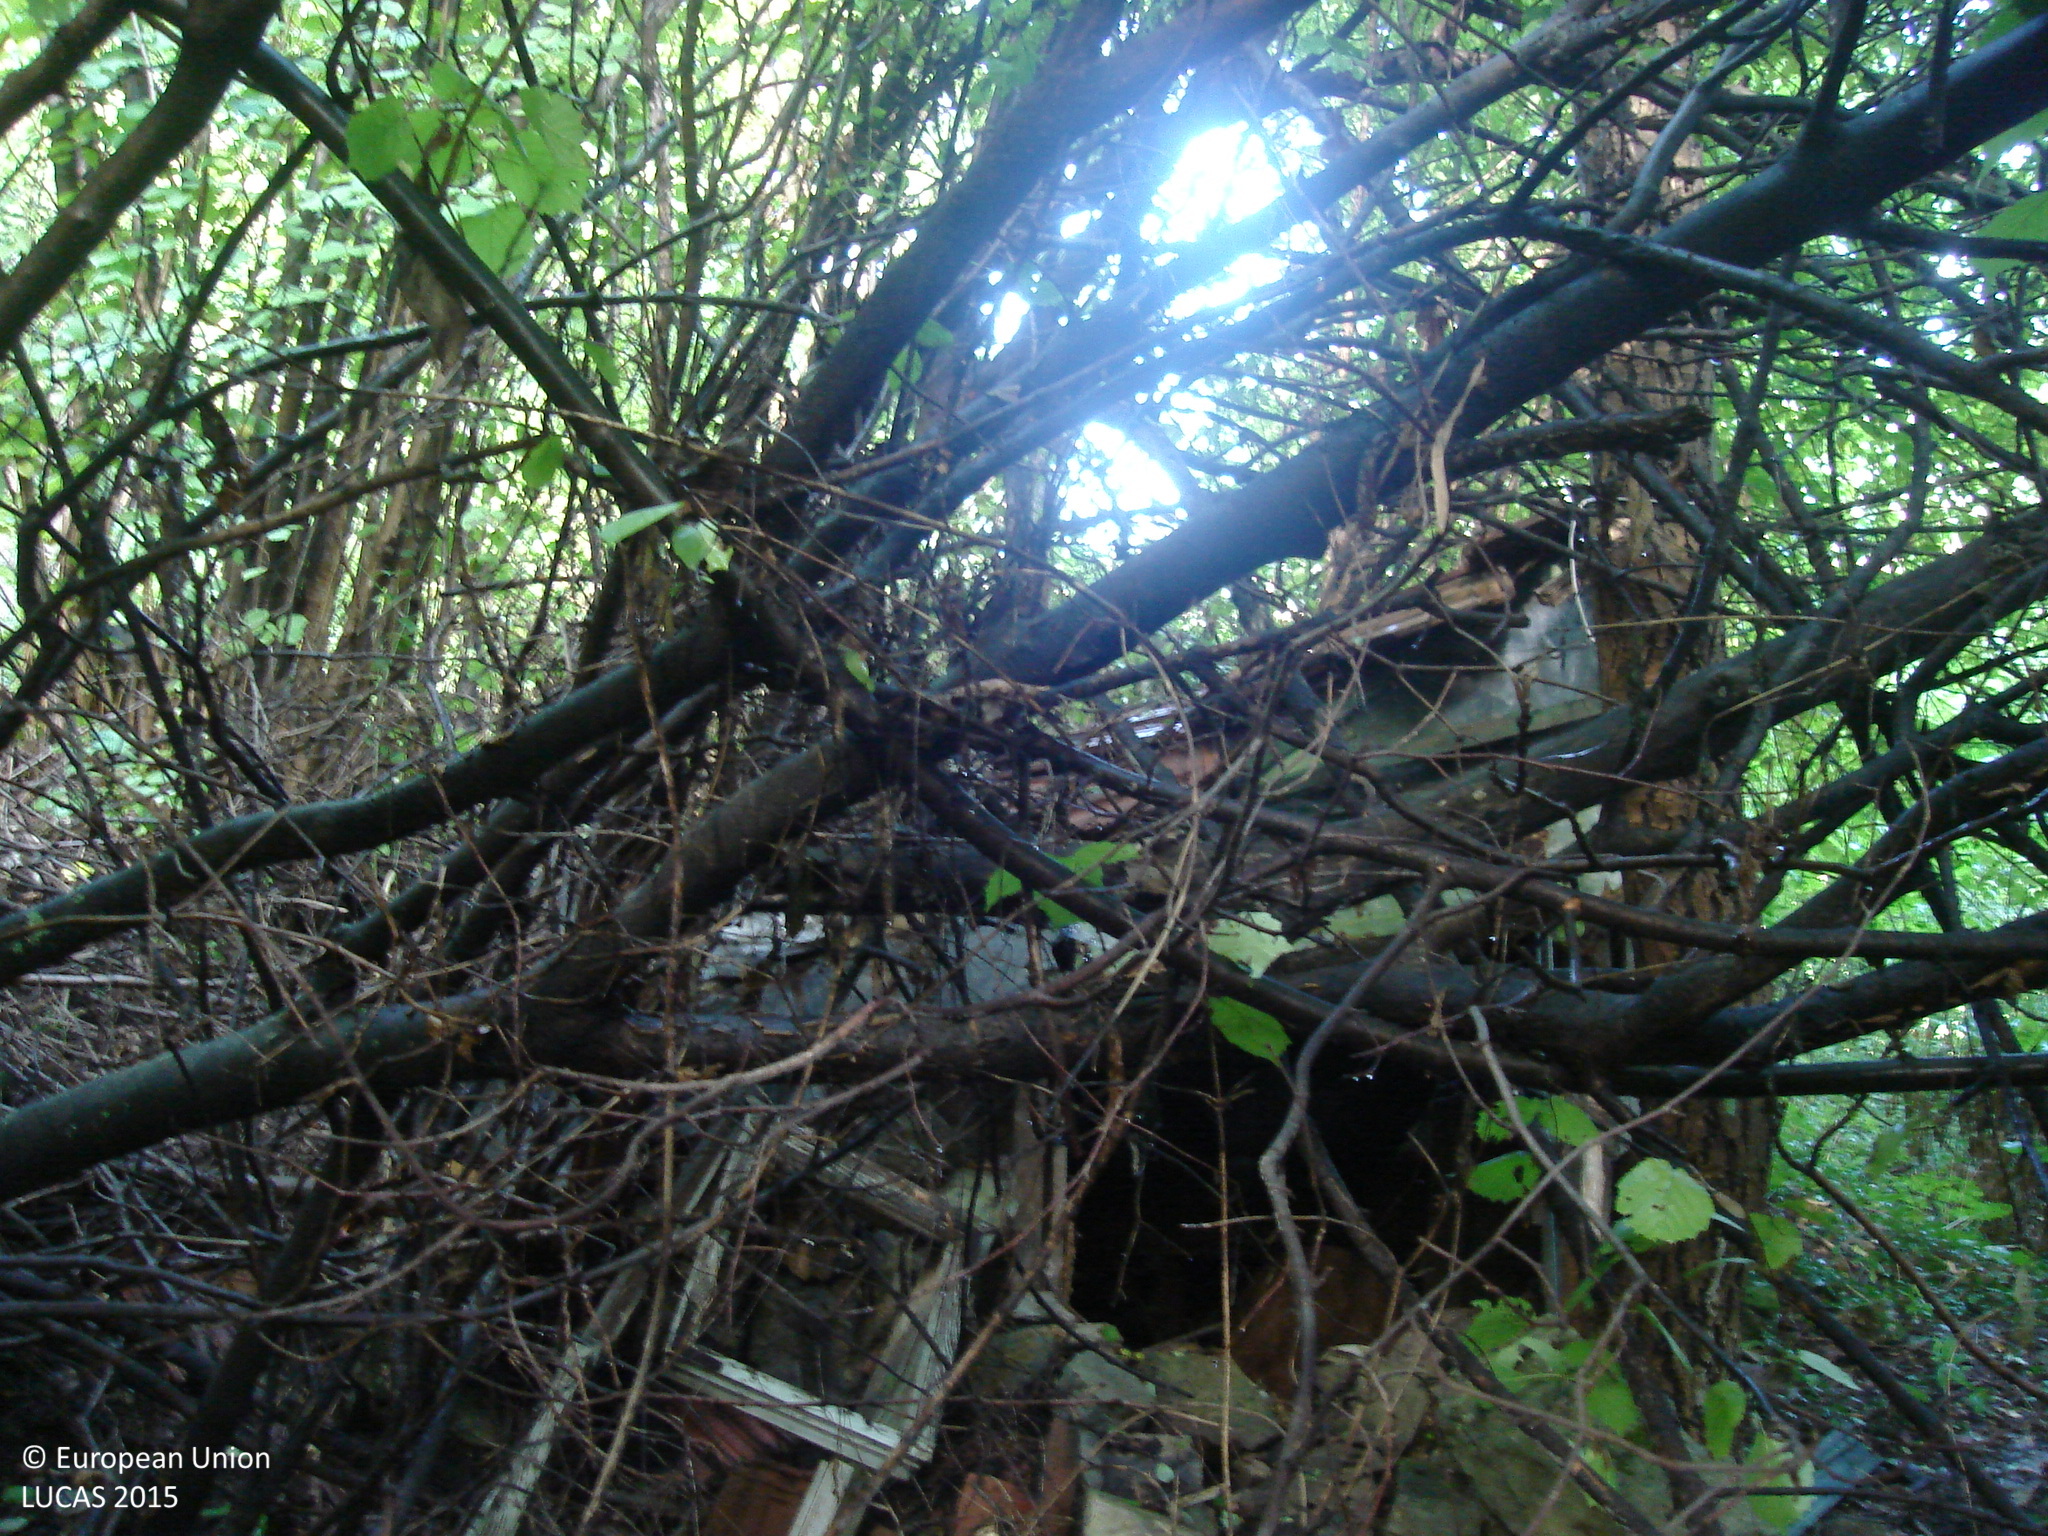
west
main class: Woodland
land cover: Broadleaved woodland
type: mesophytic deciduous forest
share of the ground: > 75 %
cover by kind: broadleaved forest trees 80 %, unconsolidated bare surface 10 %, shrubs 5 %, lichens and mosses 5 %
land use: Forestry
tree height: > 5 m
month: October
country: BG
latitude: 43.0910
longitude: 23.4178
